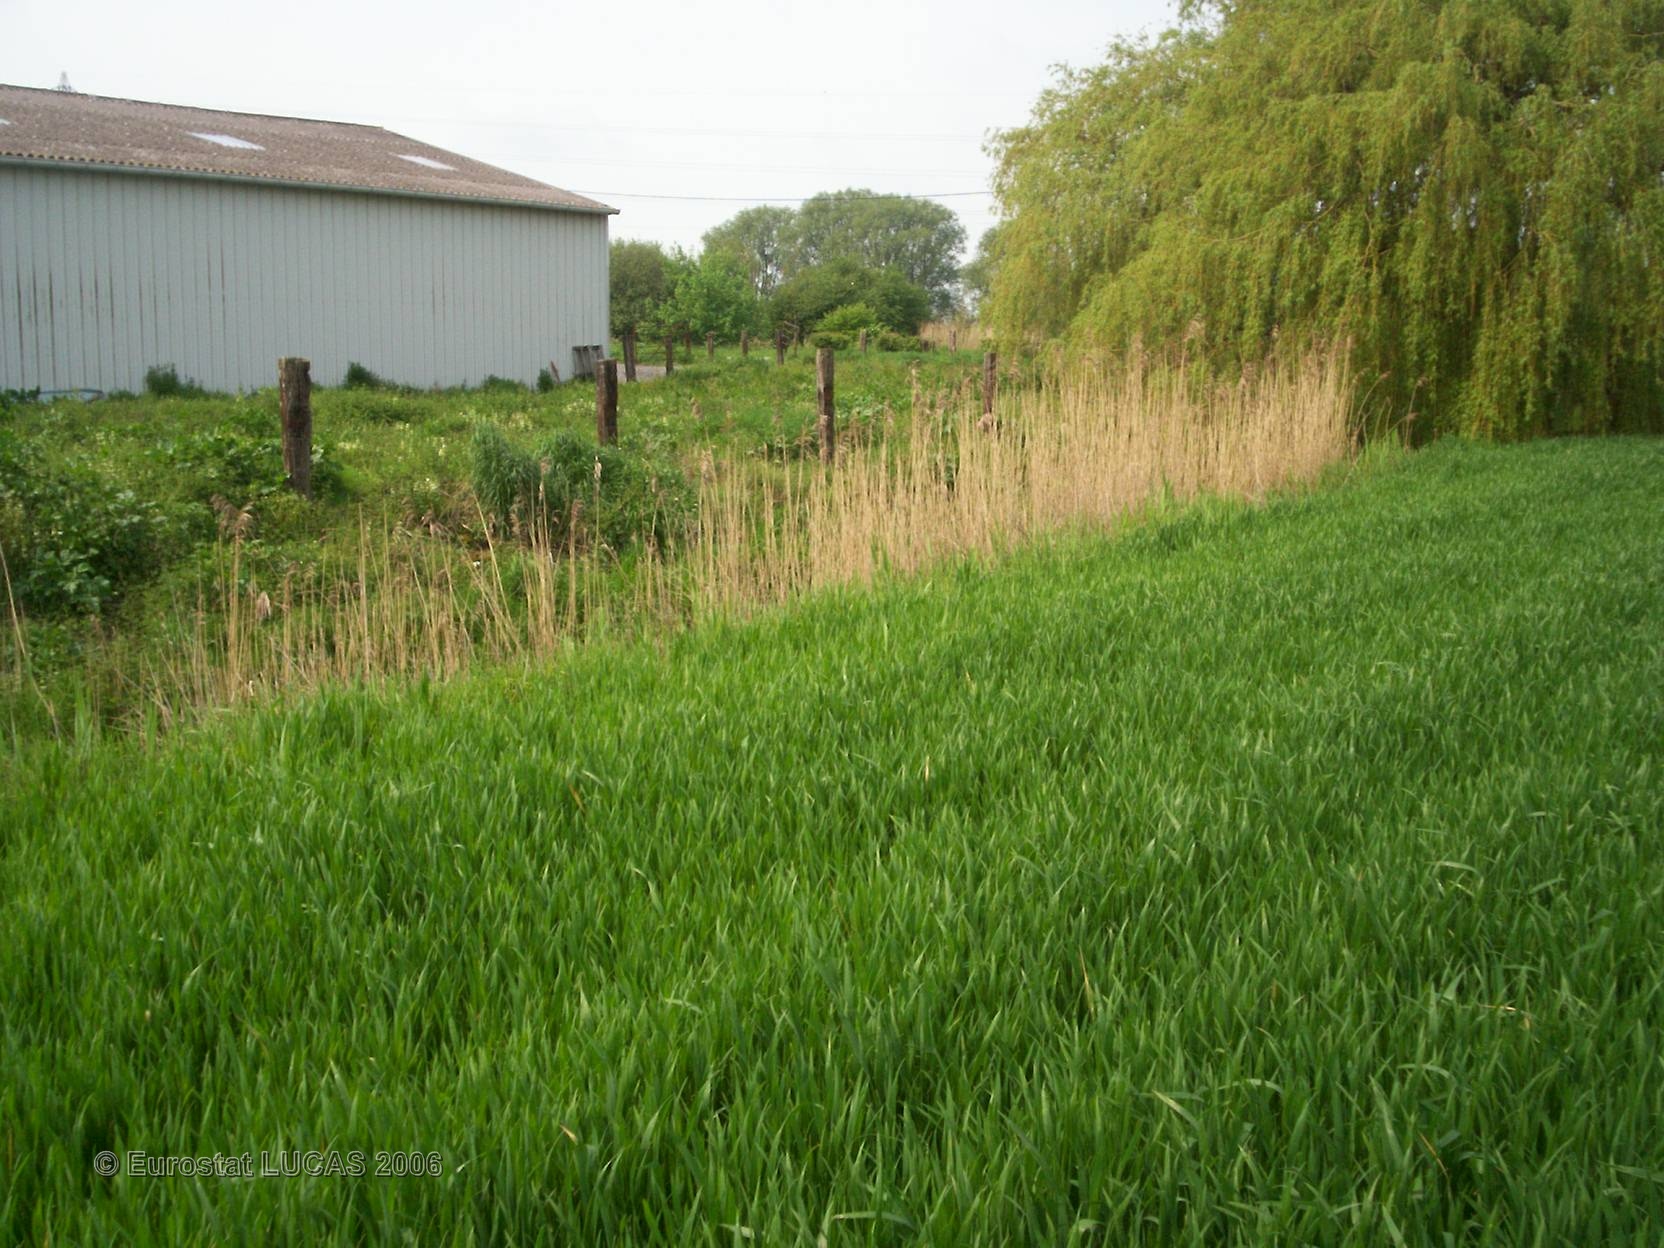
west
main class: Cropland
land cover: Common wheat
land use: Agriculture (excluding fallow land and kitchen gardens)
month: May
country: FR
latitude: 50.9701
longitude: 2.2818
